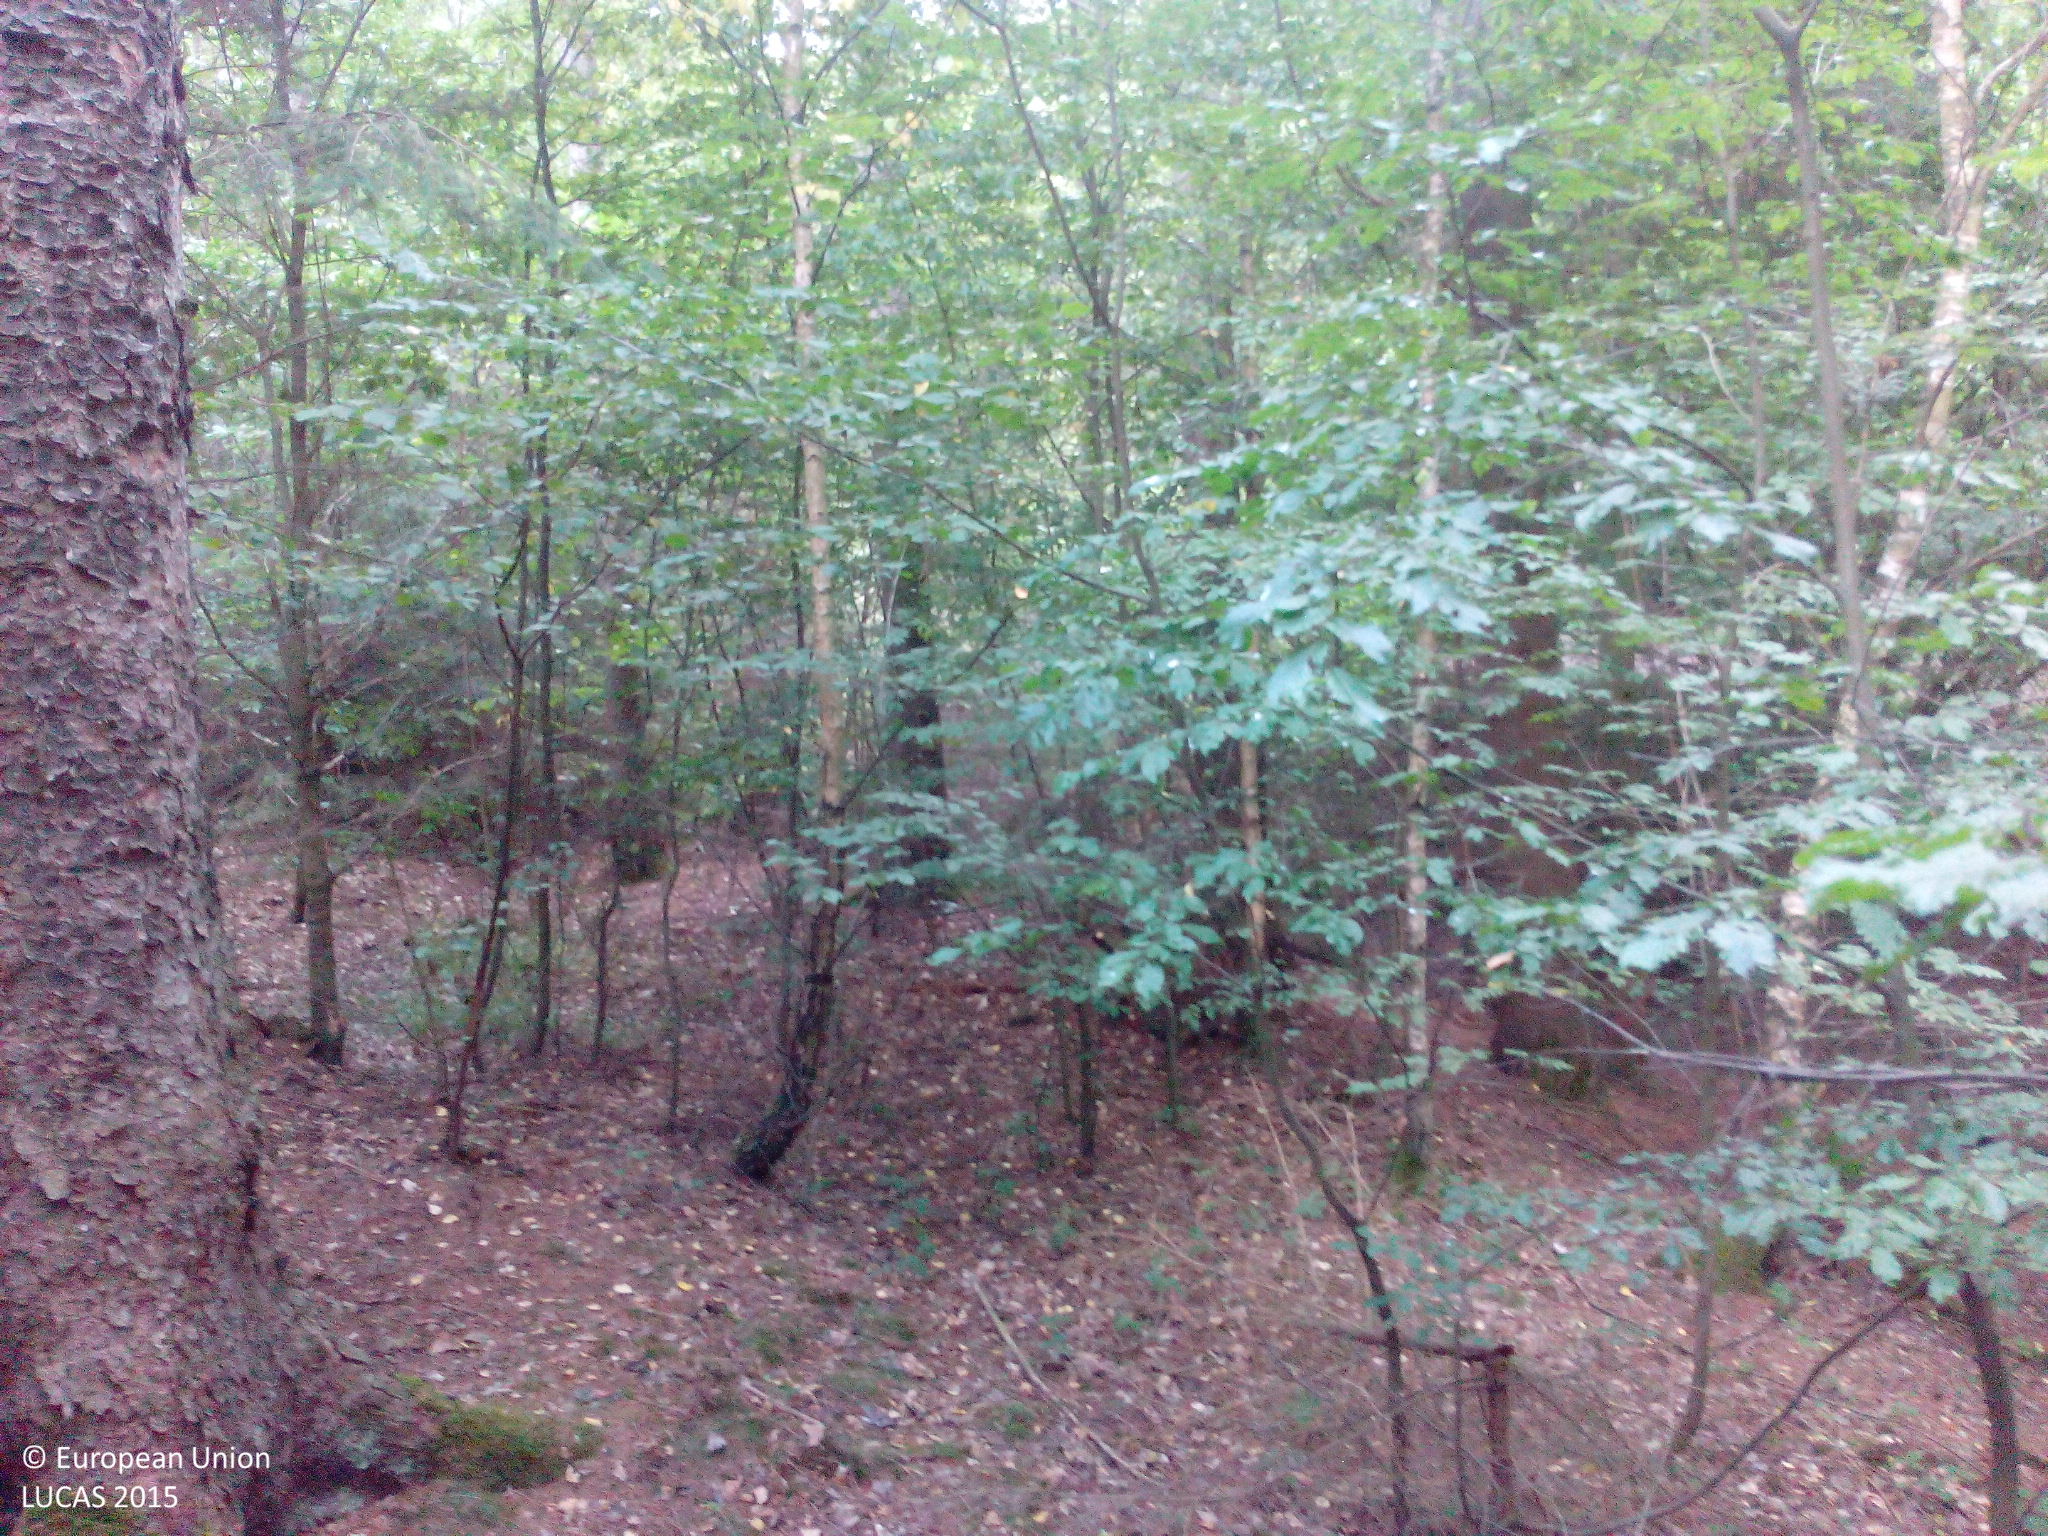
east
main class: Woodland
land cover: Spruce dominated mixed woodland
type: mesophytic deciduous forest
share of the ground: > 75 %
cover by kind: coniferous forest trees 50 %, broadleaved forest trees 25 %, herbaceous plants 10 %, lichens and mosses 10 %, unconsolidated bare surface 5 %
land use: Forestry
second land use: Amenities, museums, leisure
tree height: > 5 m
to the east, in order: Spruce dominated mixed woodland; Rivers and streams; Spruce dominated mixed woodland; Tracks; Broadleaved woodland; Tracks; Broadleaved woodland; Rivers and streams; Broadleaved woodland; Spruce dominated mixed woodland
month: August
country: DE
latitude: 50.2119
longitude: 7.5480
